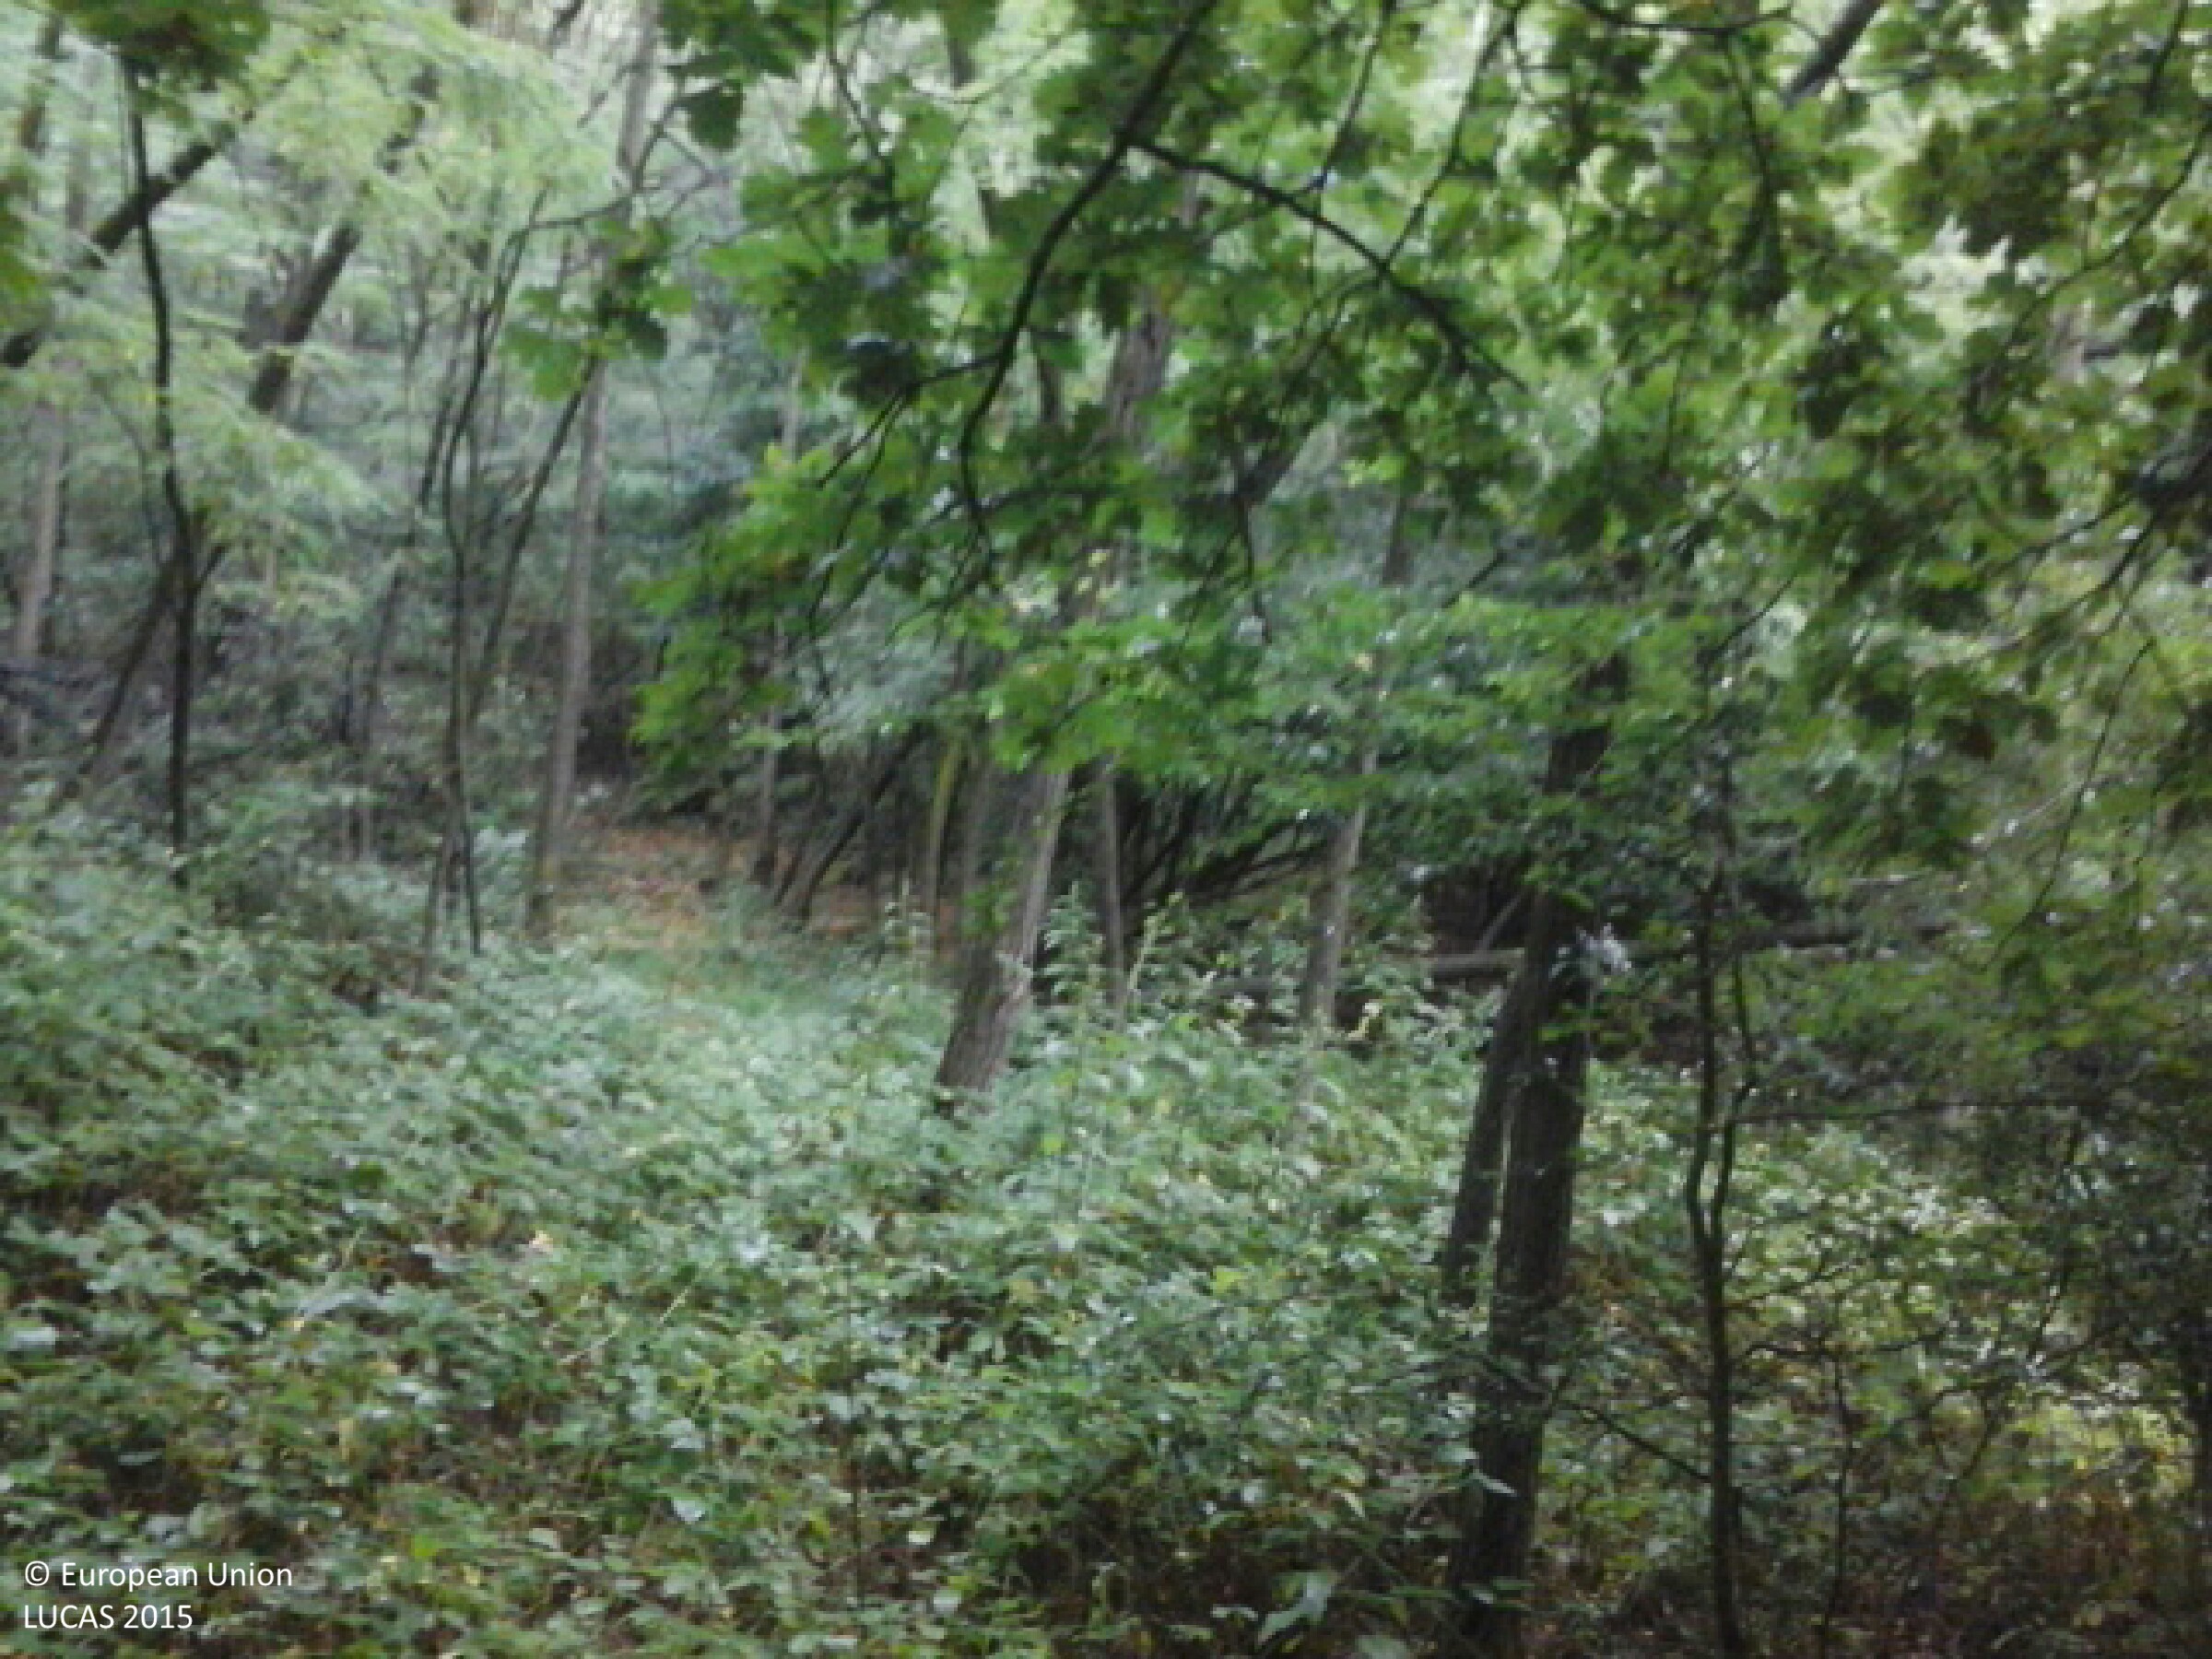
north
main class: Woodland
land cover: Broadleaved woodland
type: mesophytic deciduous forest
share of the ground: > 75 %
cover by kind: broadleaved forest trees 95 %, shrubs 5 %
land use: Forestry
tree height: > 5 m
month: July
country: HU
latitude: 48.5031
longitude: 21.5658
